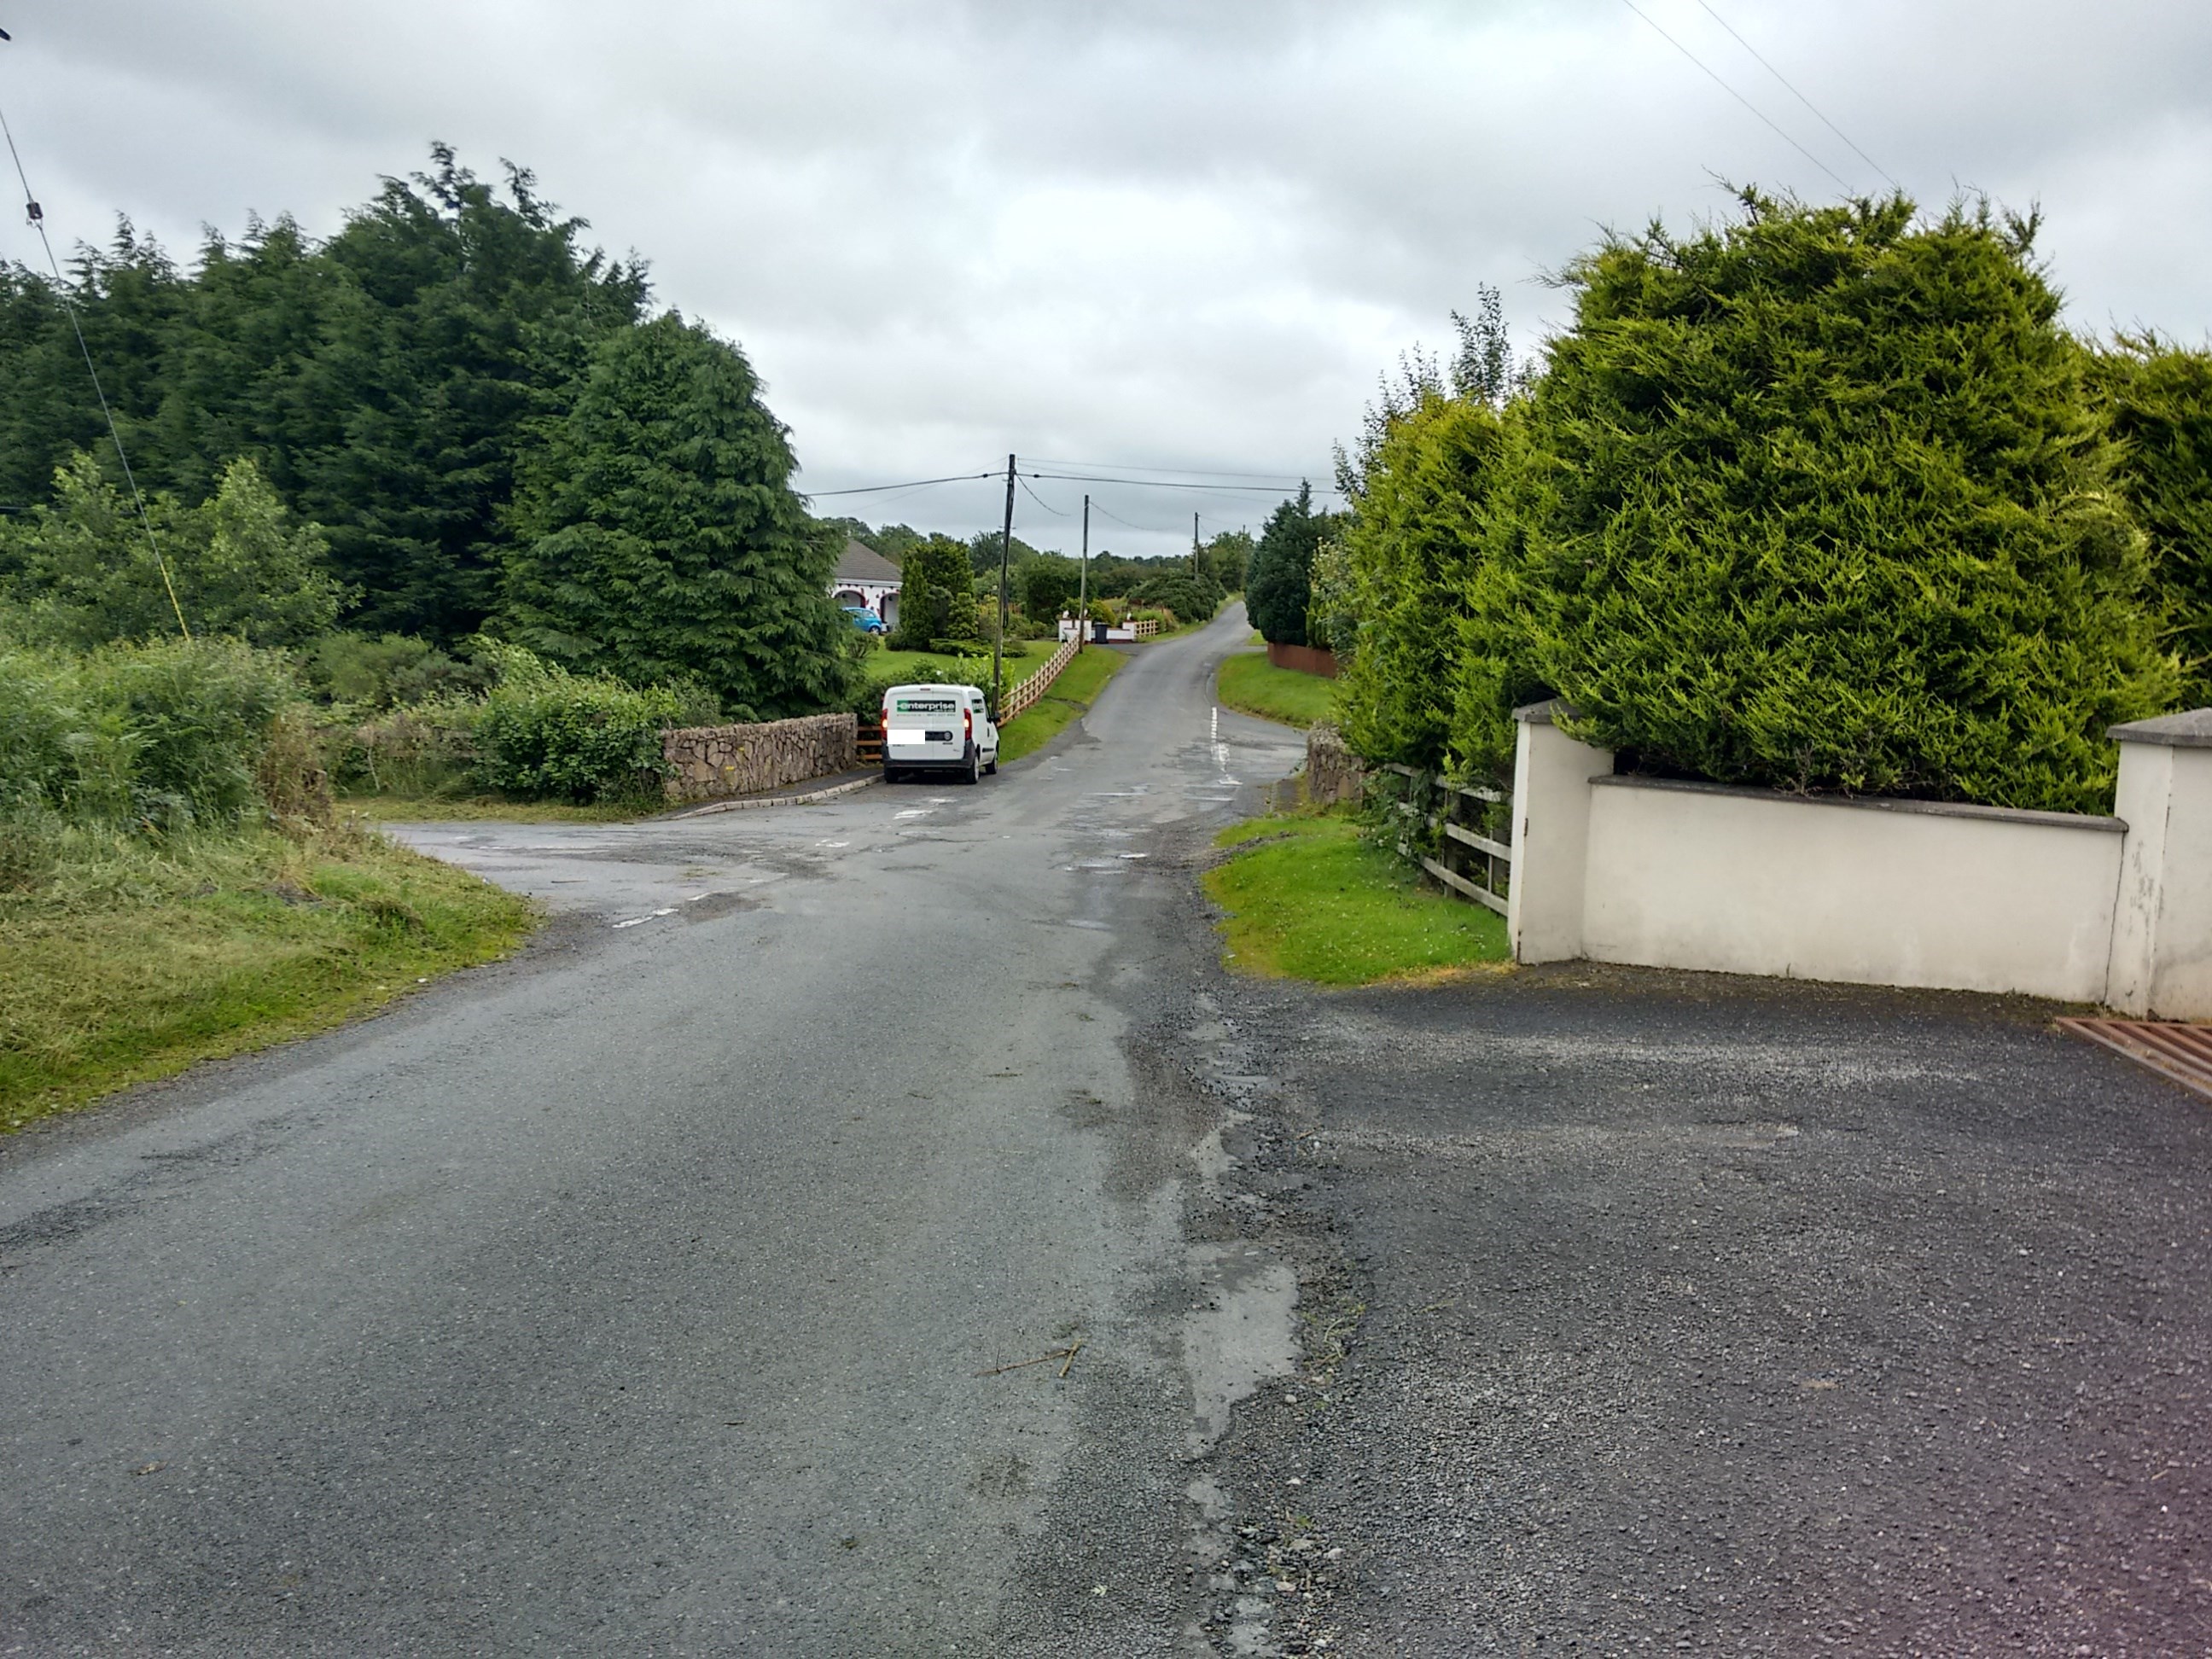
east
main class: Grassland
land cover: Grassland with sparse tree/shrub cover
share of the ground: > 75 %
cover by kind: herbaceous plants 85 %, shrubs 10 %, broadleaved forest trees 5 %
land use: Agriculture (excluding fallow land and kitchen gardens)
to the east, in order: Grass margins; Fences; Managed hedges; Artificial constructions in urban areas; Abandoned hedges; Grassland without tree/shrub cover; Broadleaved woodland; Artificial constructions in urban areas; Ditches and canals; Abandoned hedges
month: August
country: GB
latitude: 54.6330
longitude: -6.8821
